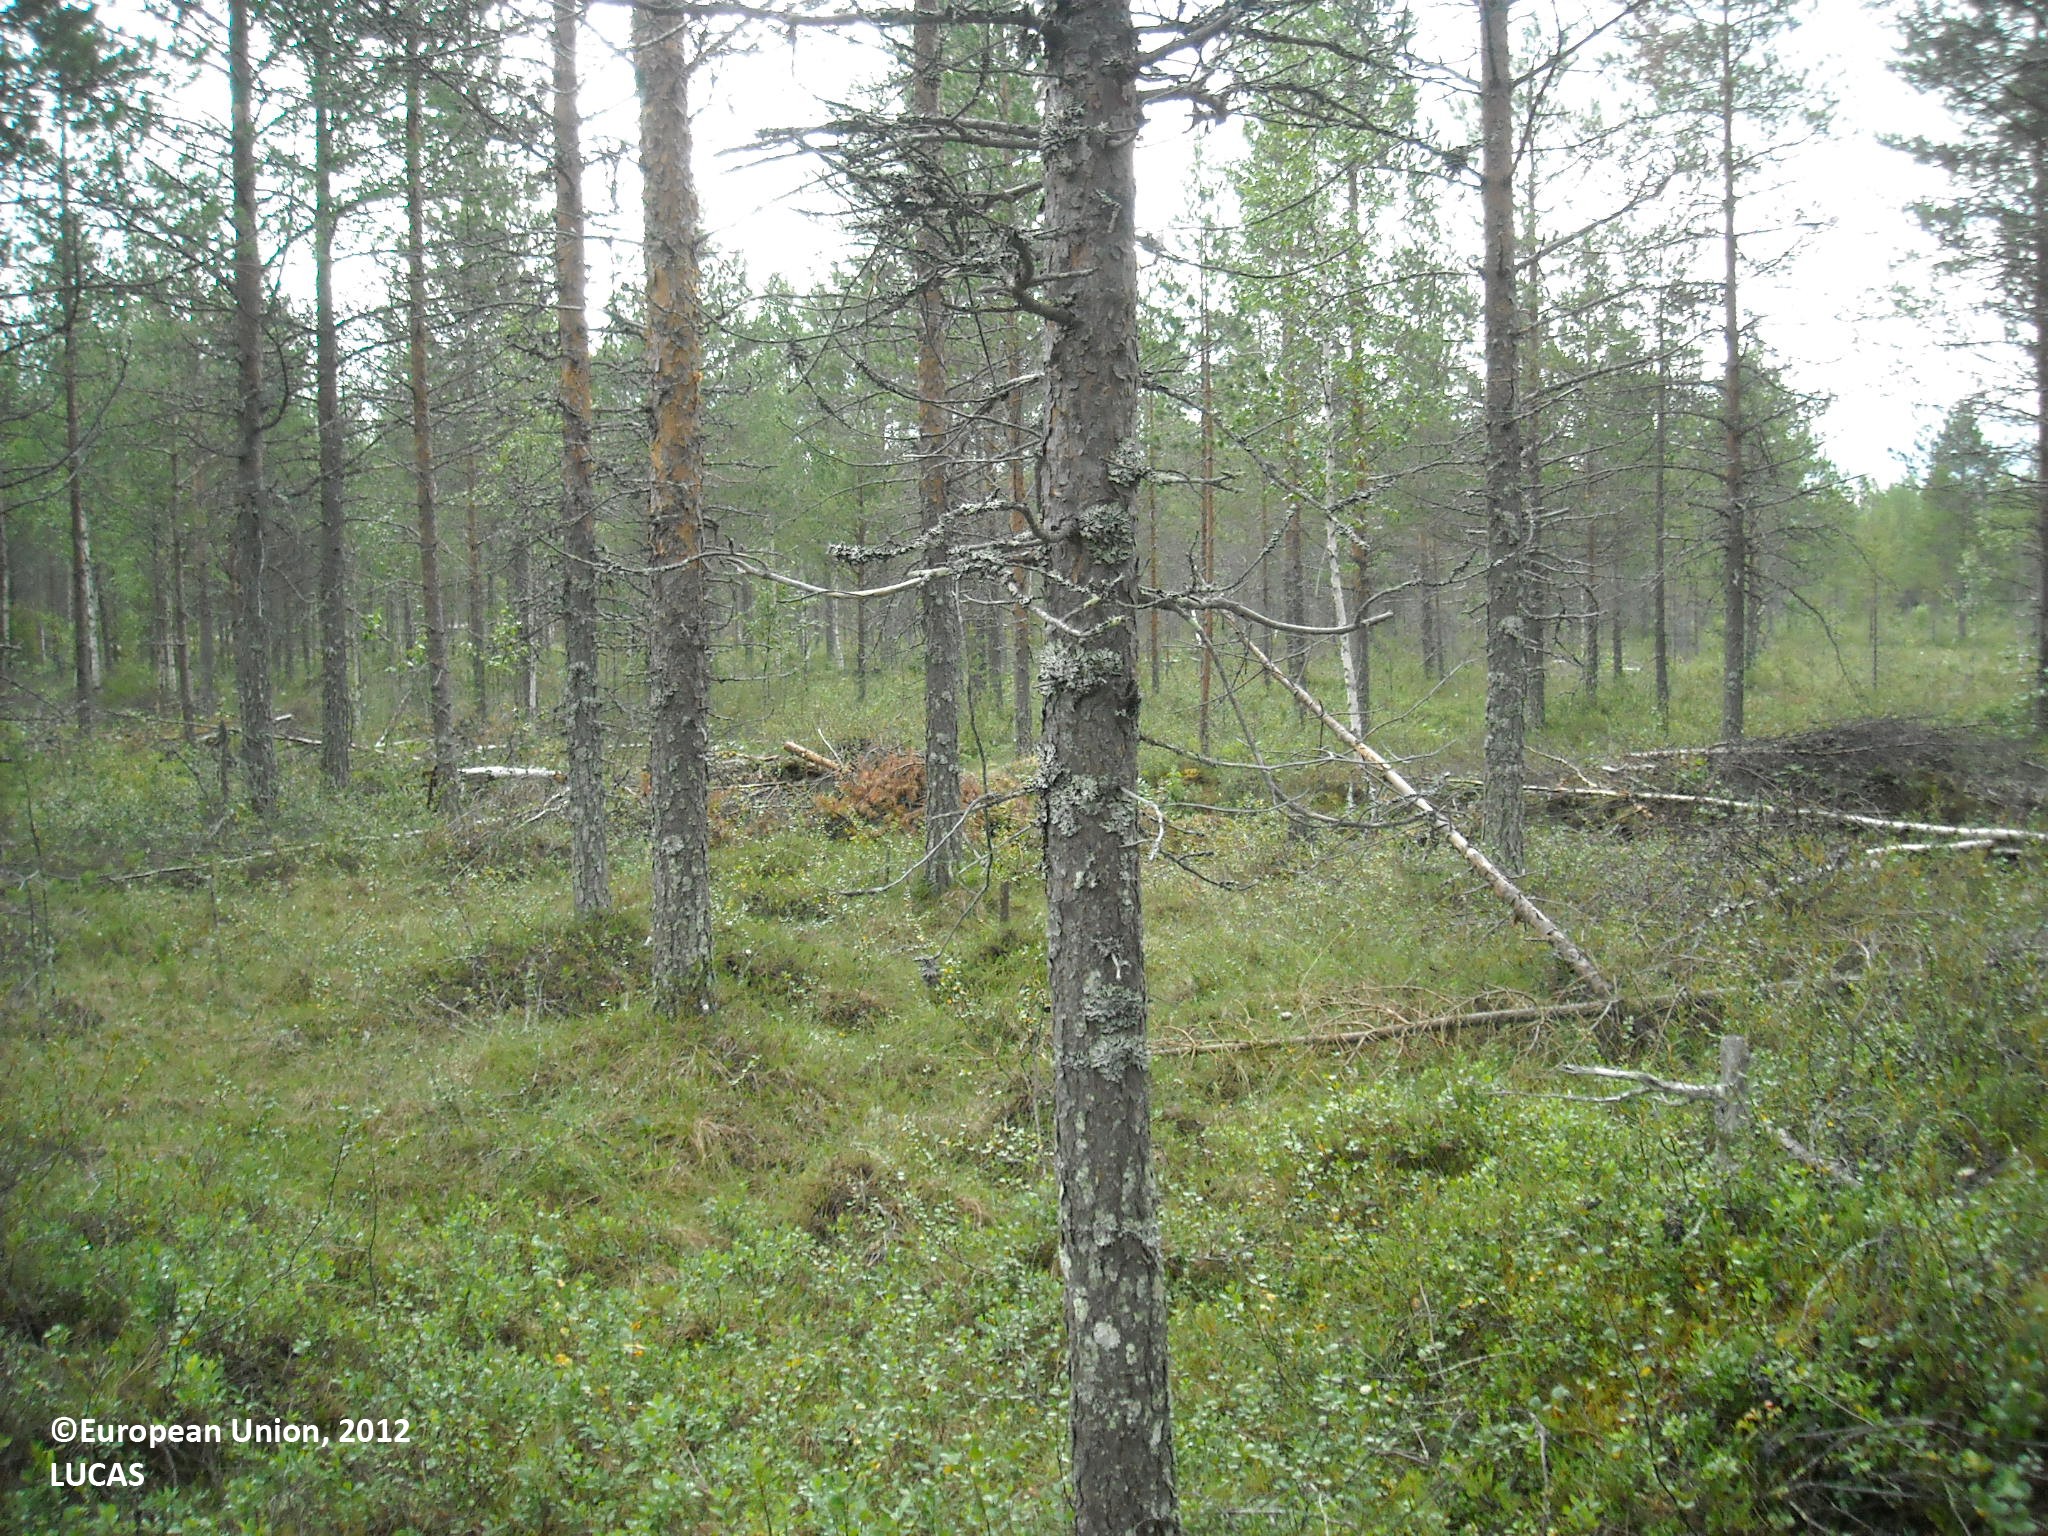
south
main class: Woodland
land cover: Pine dominated mixed woodland
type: mire and swamp forests
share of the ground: 50 - 75 %
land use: Forestry
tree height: > 5 m
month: July
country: FI
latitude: 64.9646
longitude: 27.6127
